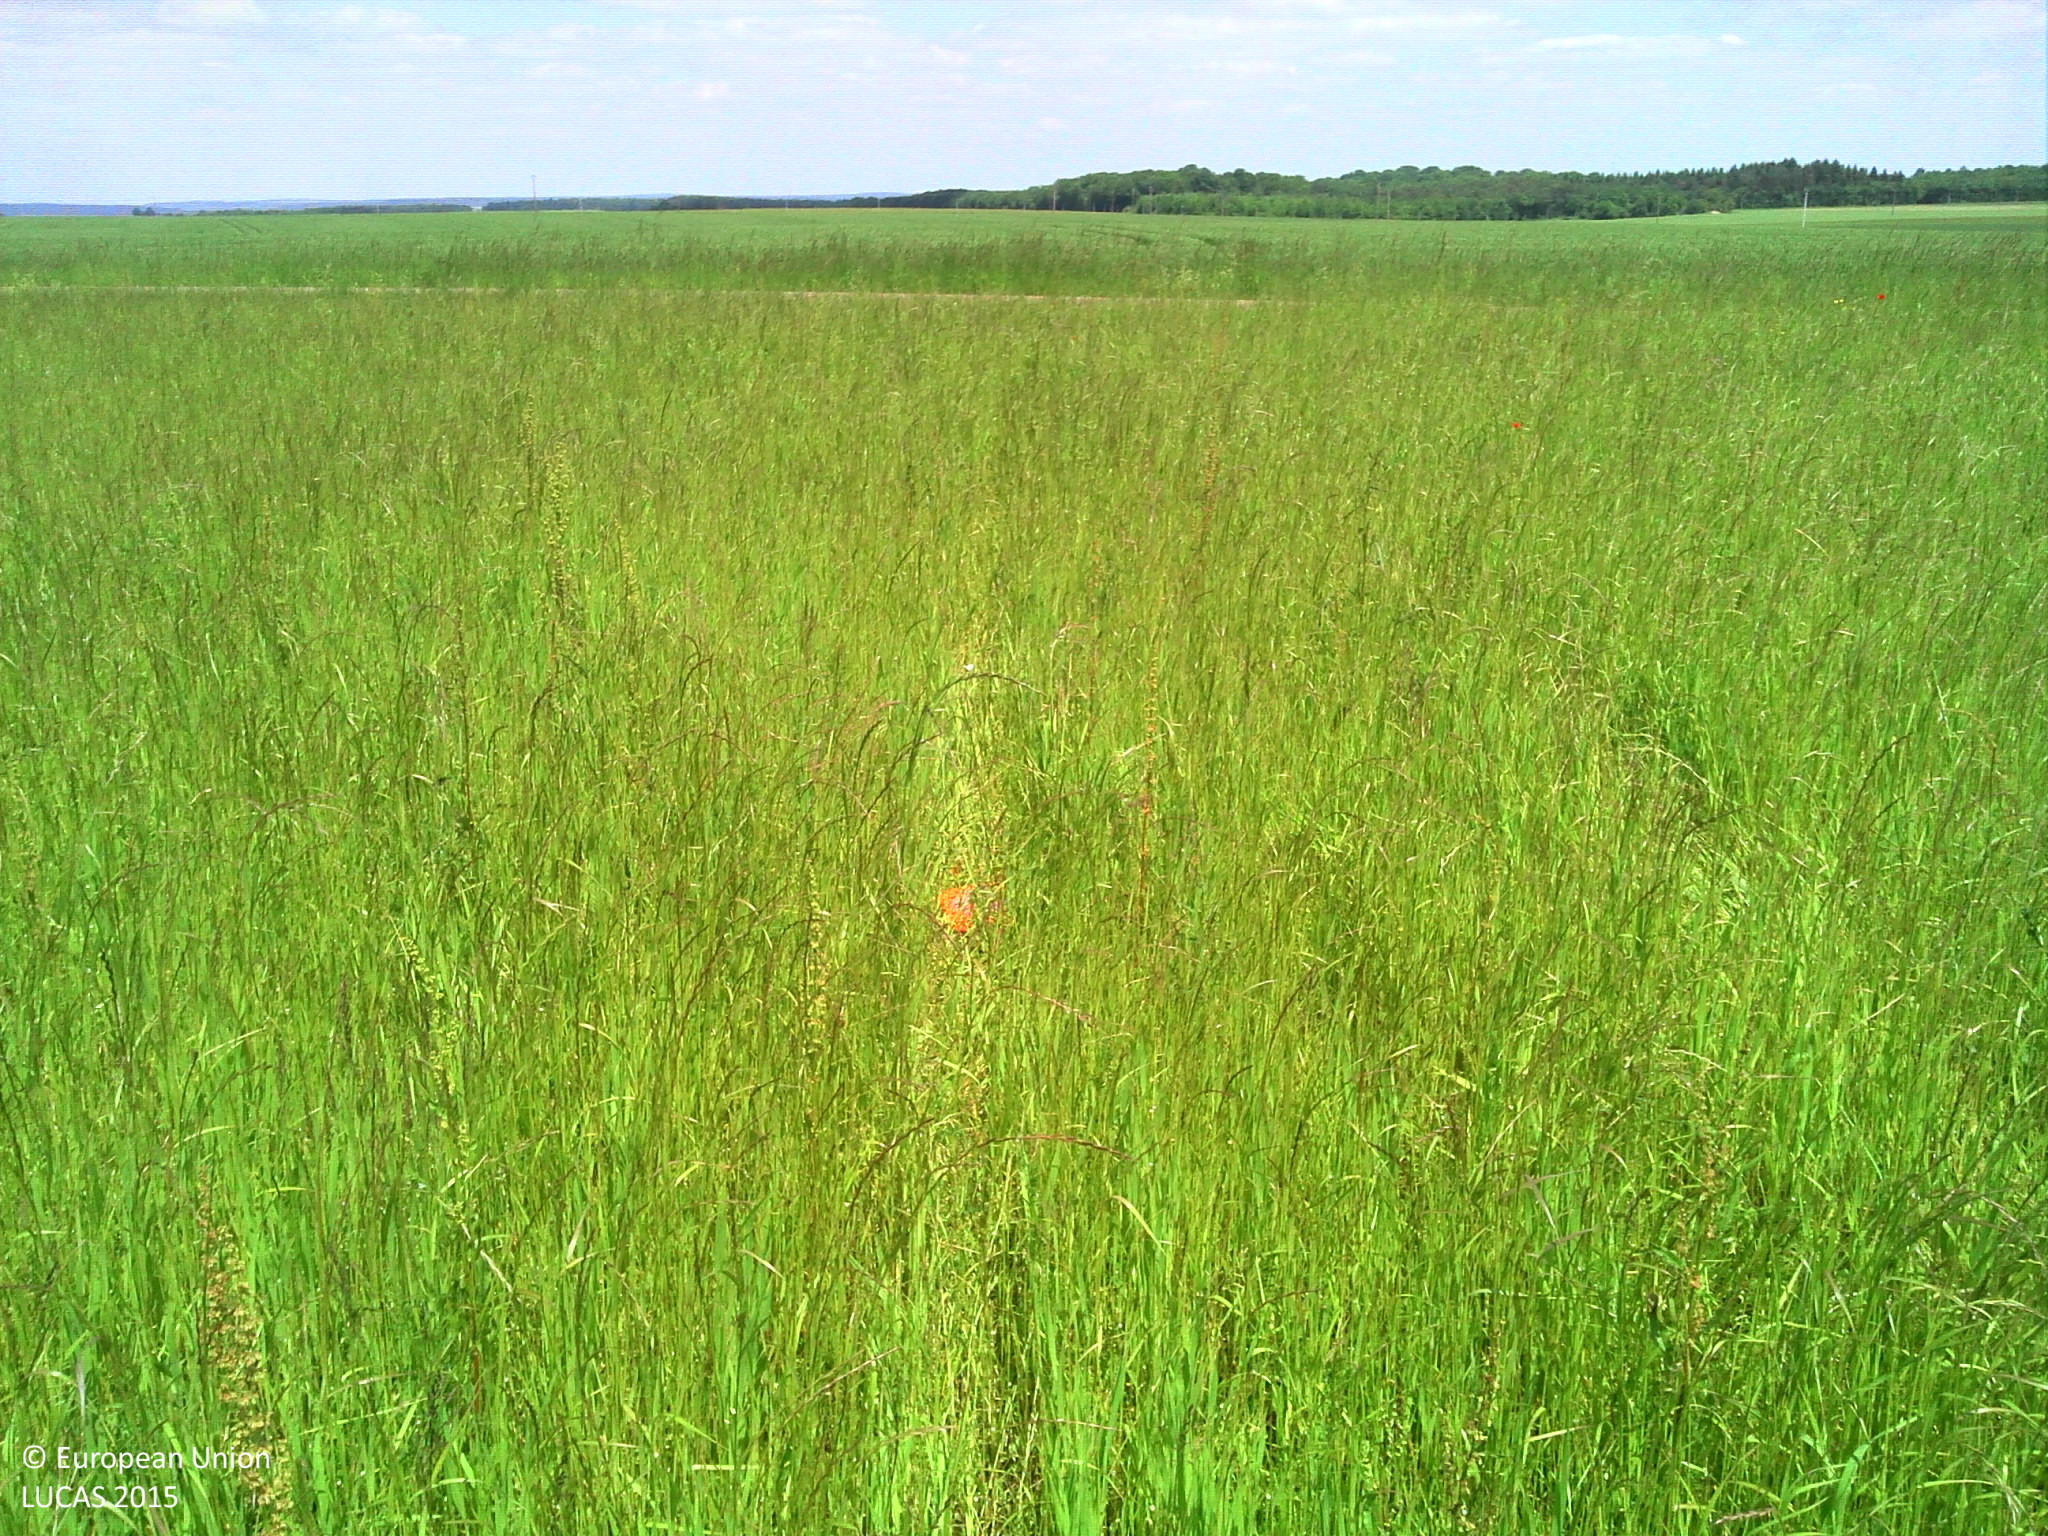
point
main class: Cropland
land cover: Temporary grasslands
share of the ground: > 75 %
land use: Agriculture (excluding fallow land and kitchen gardens)
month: May
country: FR
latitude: 47.7694
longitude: 4.3004
